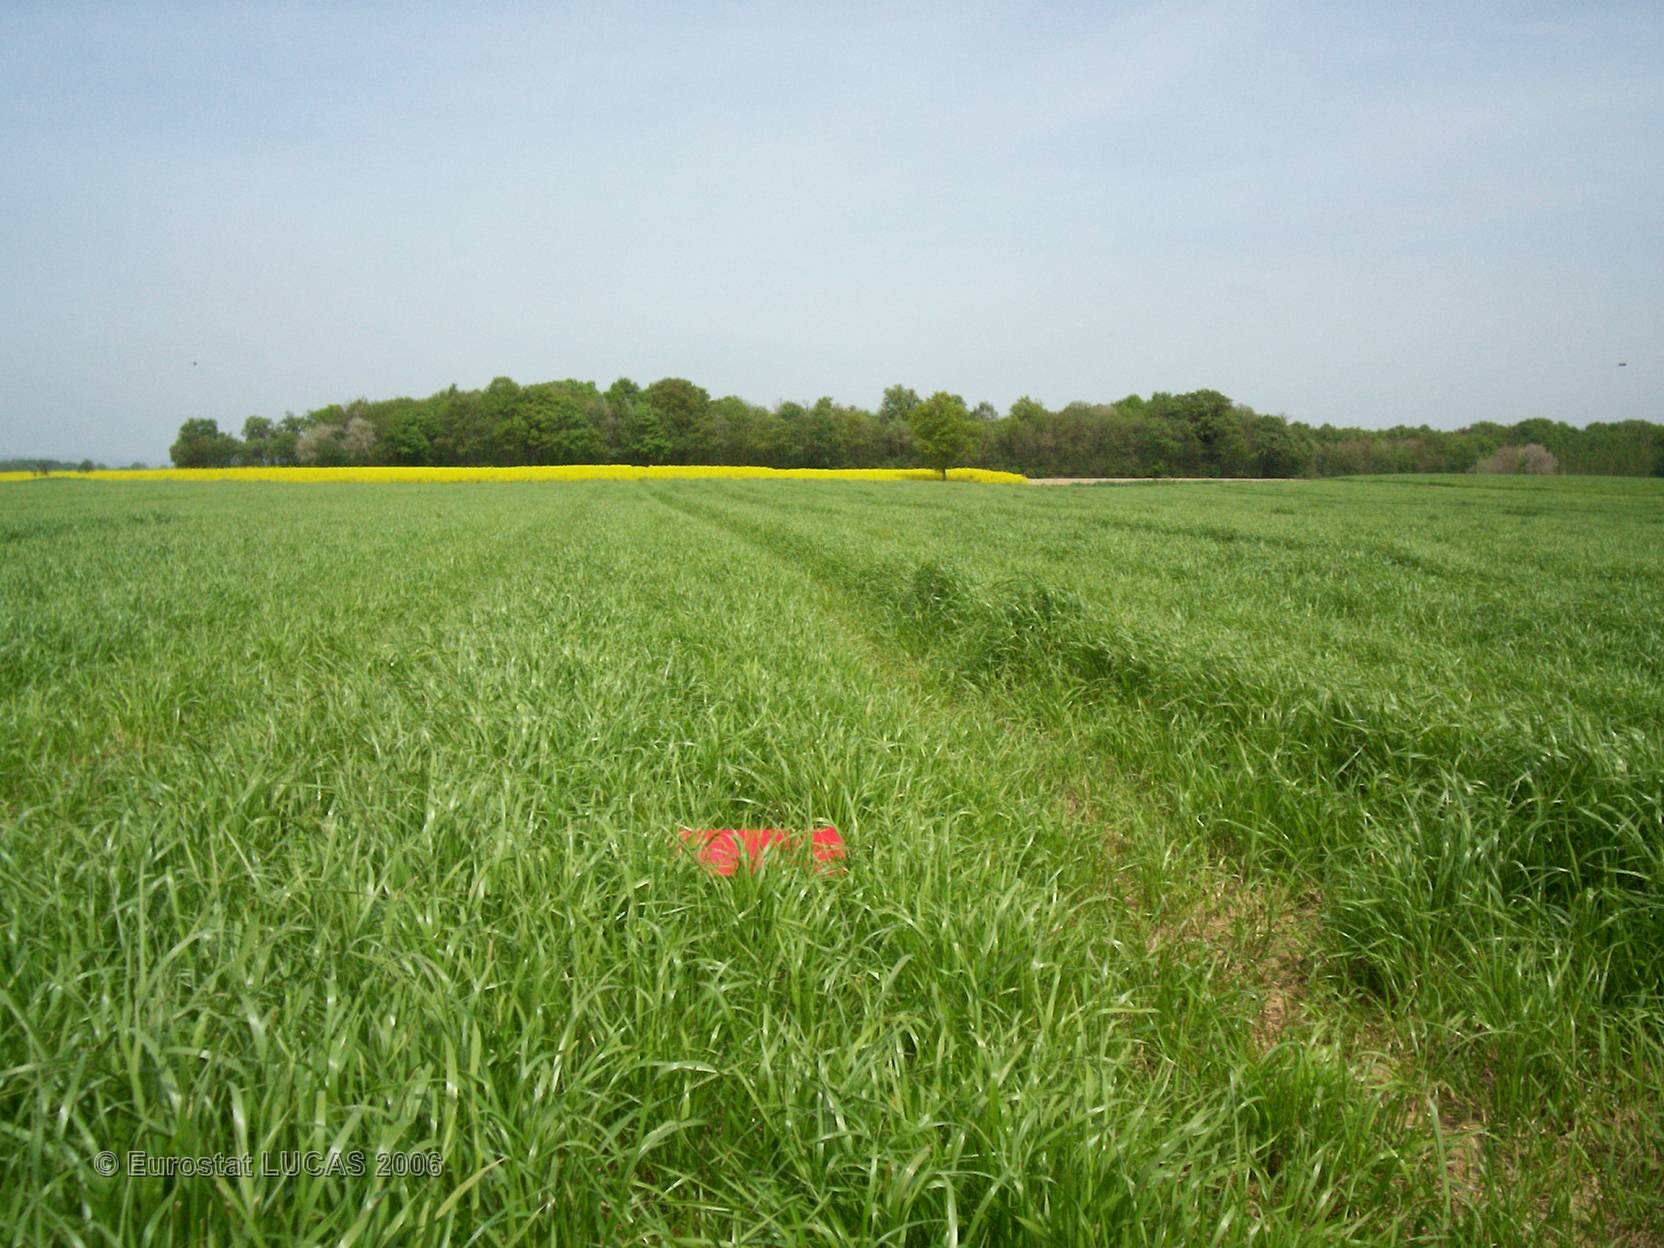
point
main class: Grassland
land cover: Grassland without tree/shrub cover
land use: Agriculture (excluding fallow land and kitchen gardens)
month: May
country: FR
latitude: 46.1735
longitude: 4.8603
